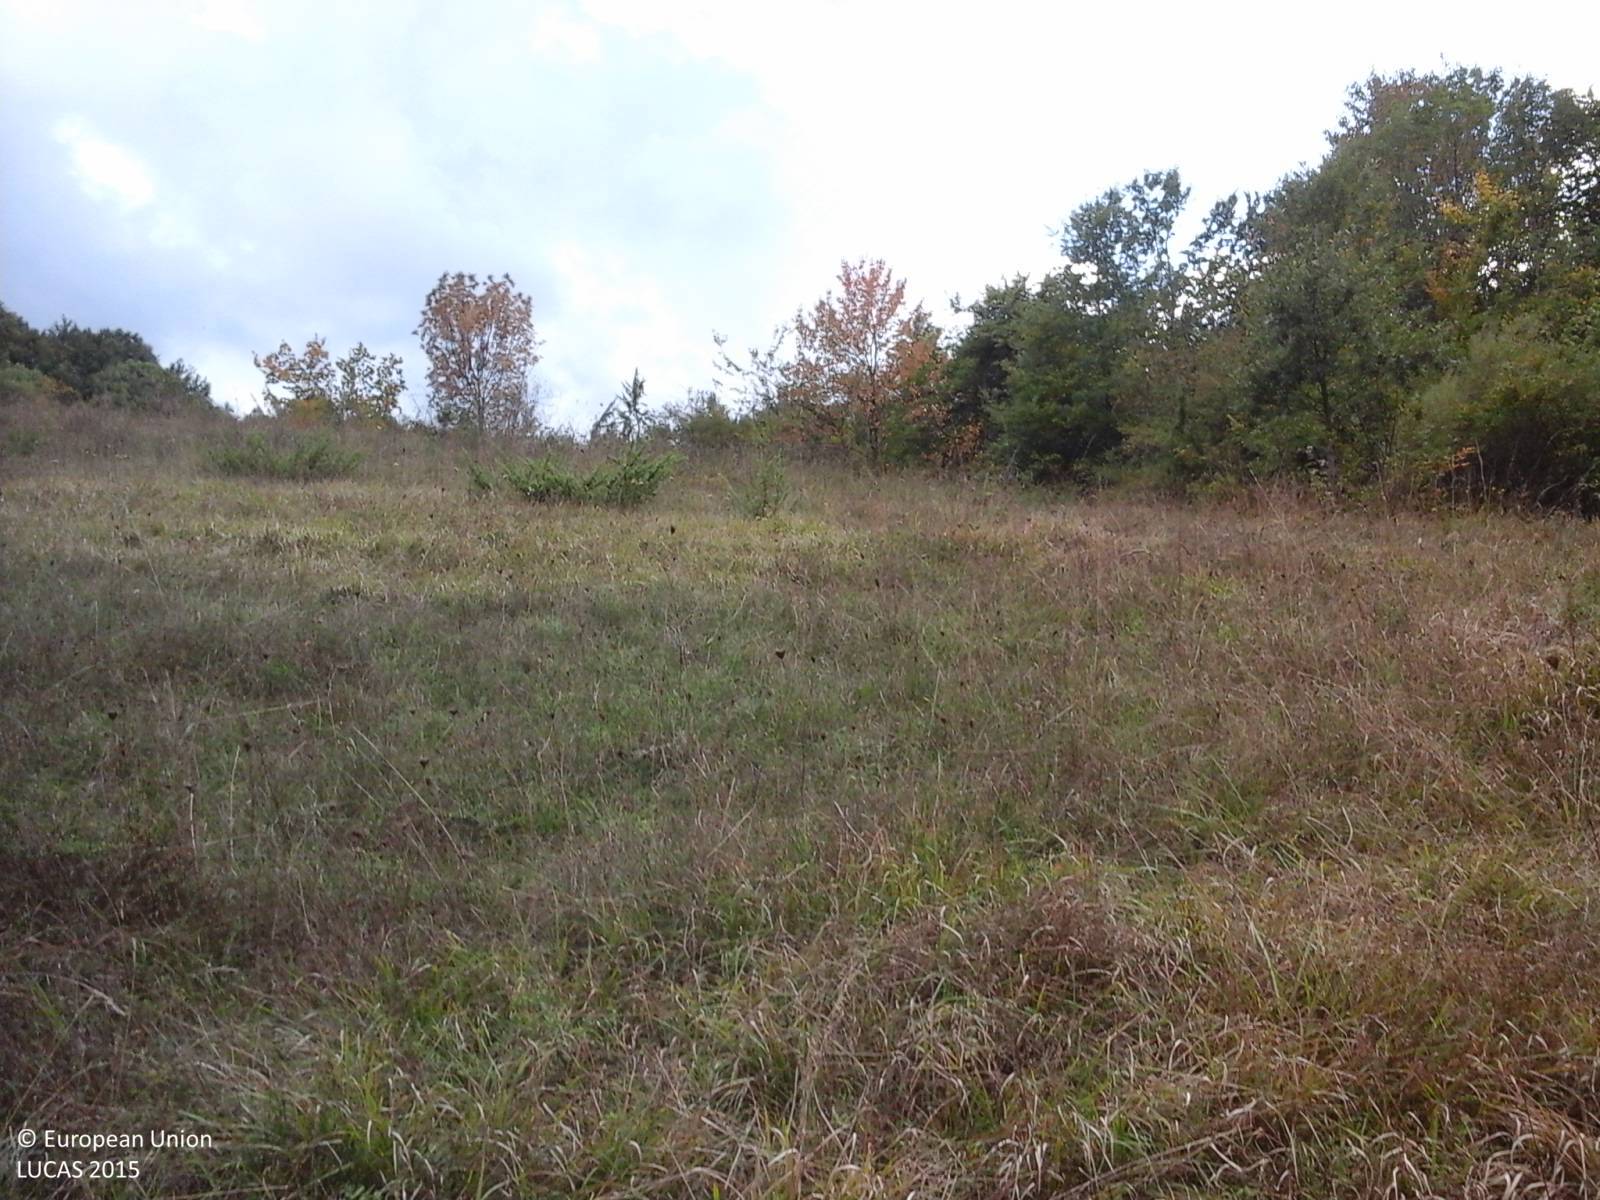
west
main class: Shrubland
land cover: Shrubland with sparse tree cover
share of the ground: > 75 %
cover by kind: shrubs 80 %, herbaceous plants 15 %, broadleaved forest trees 5 %
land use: Semi-natural and natural areas not in use
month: October
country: IT
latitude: 42.5502
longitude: 13.1686
